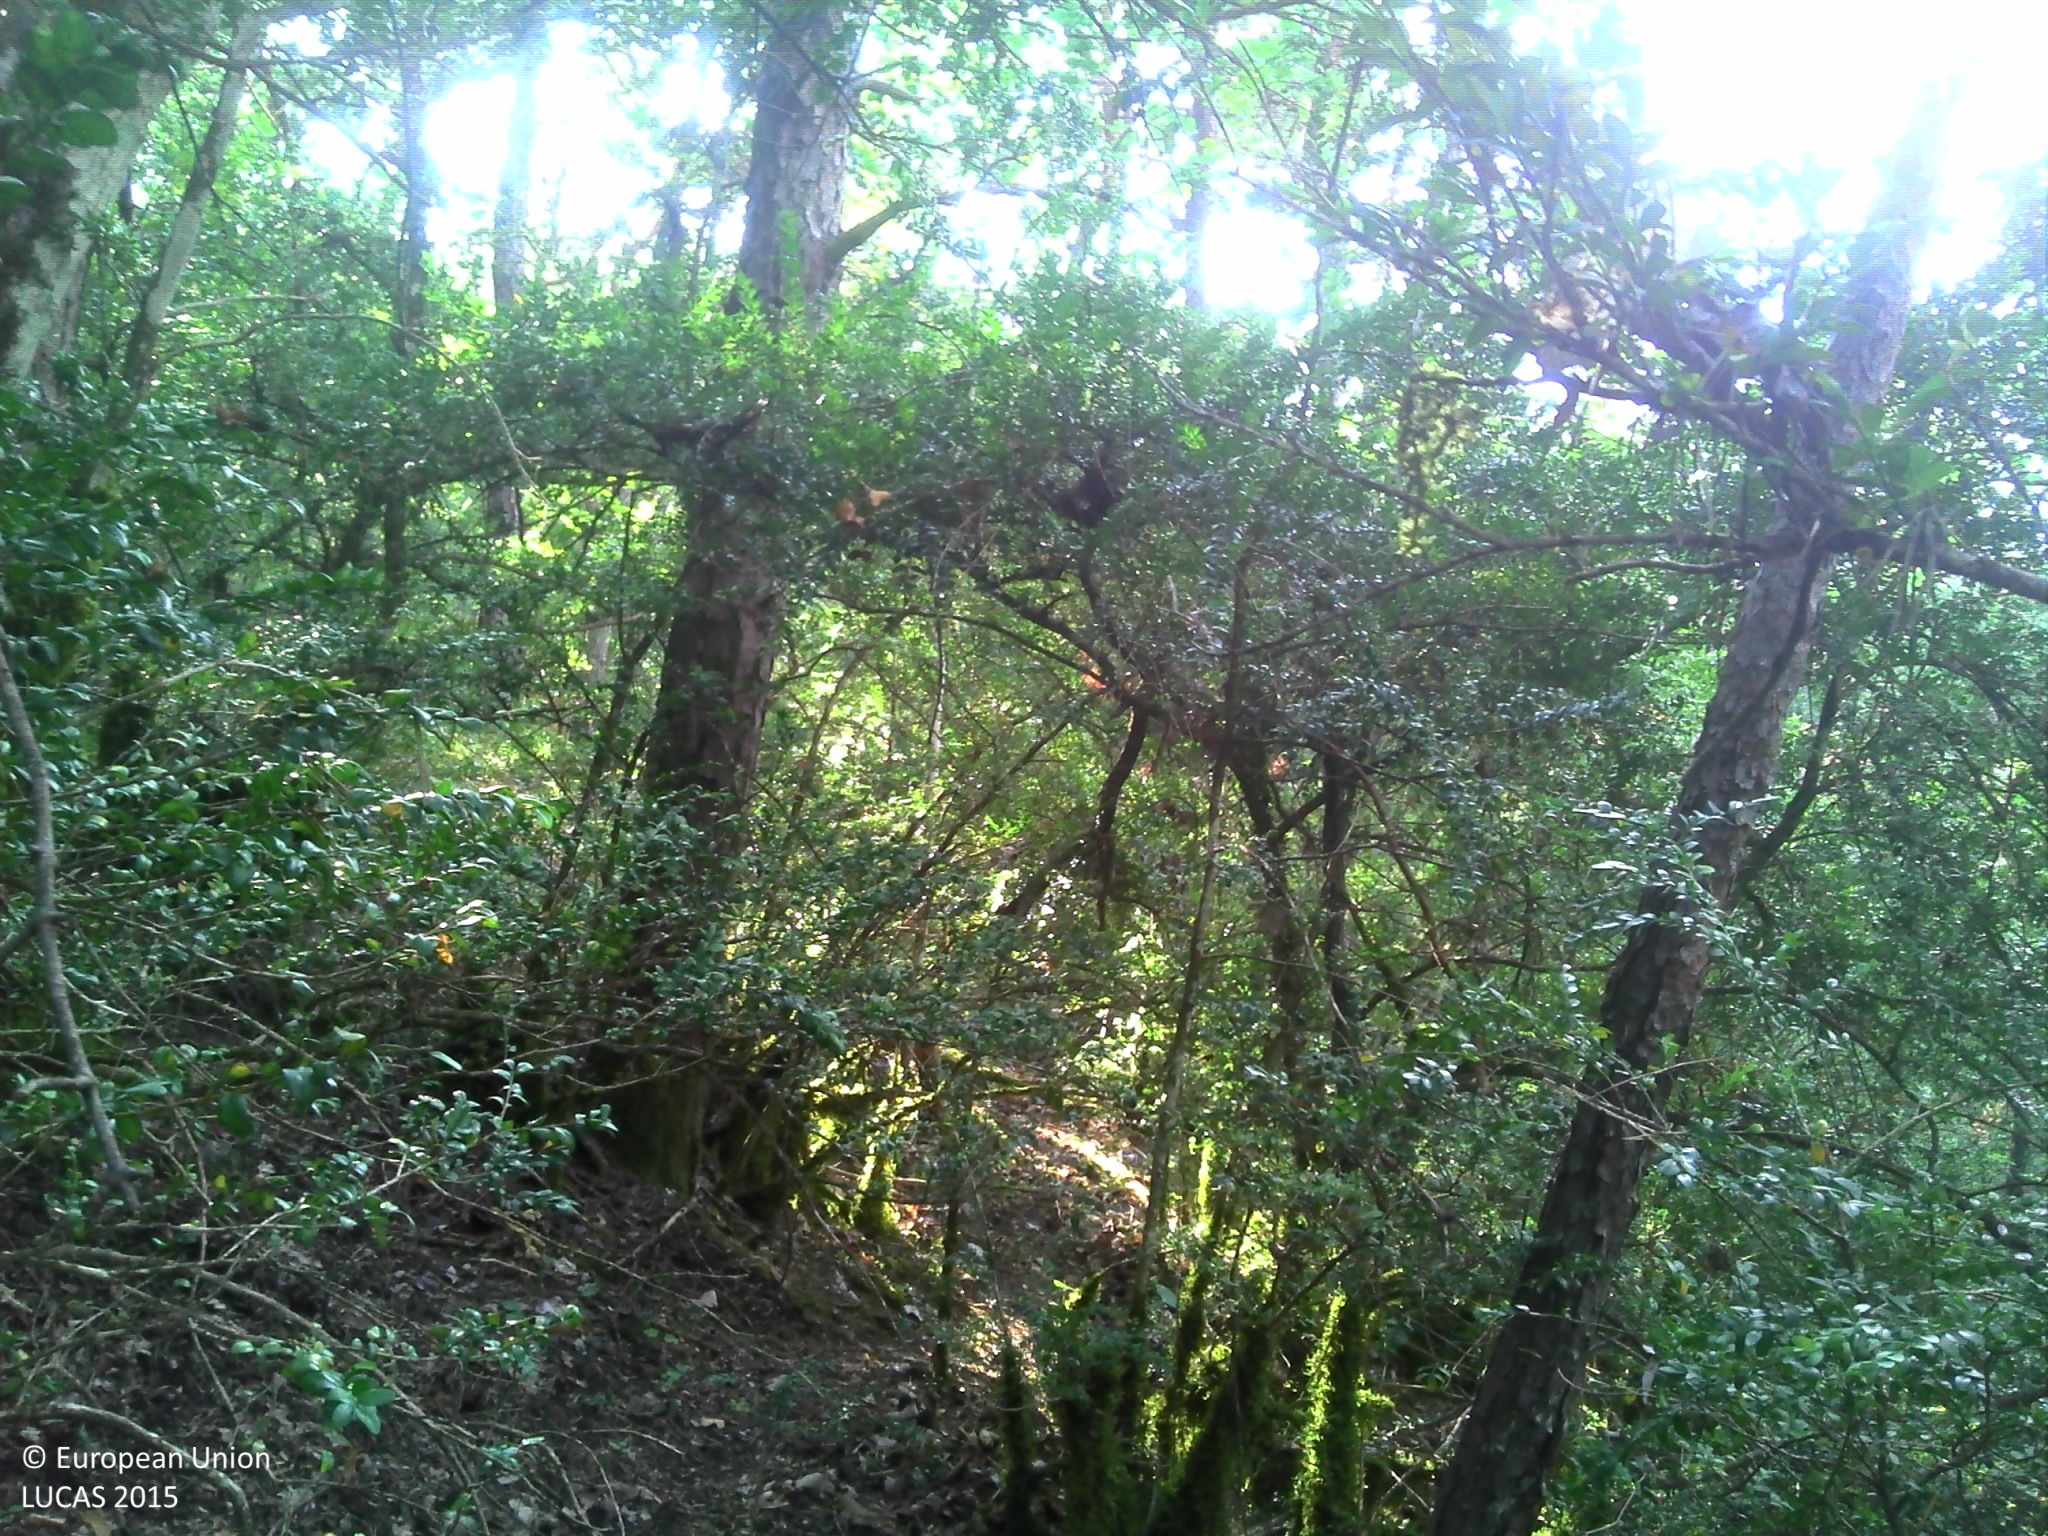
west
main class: Woodland
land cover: Pine dominated mixed woodland
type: coniferous forest of the mediterranean region
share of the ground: > 75 %
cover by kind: broadleaved forest trees 65 %, coniferous forest trees 25 %, herbaceous plants 10 %
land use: Forestry
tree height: > 5 m
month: September
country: FR
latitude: 44.6865
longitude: 5.5022
